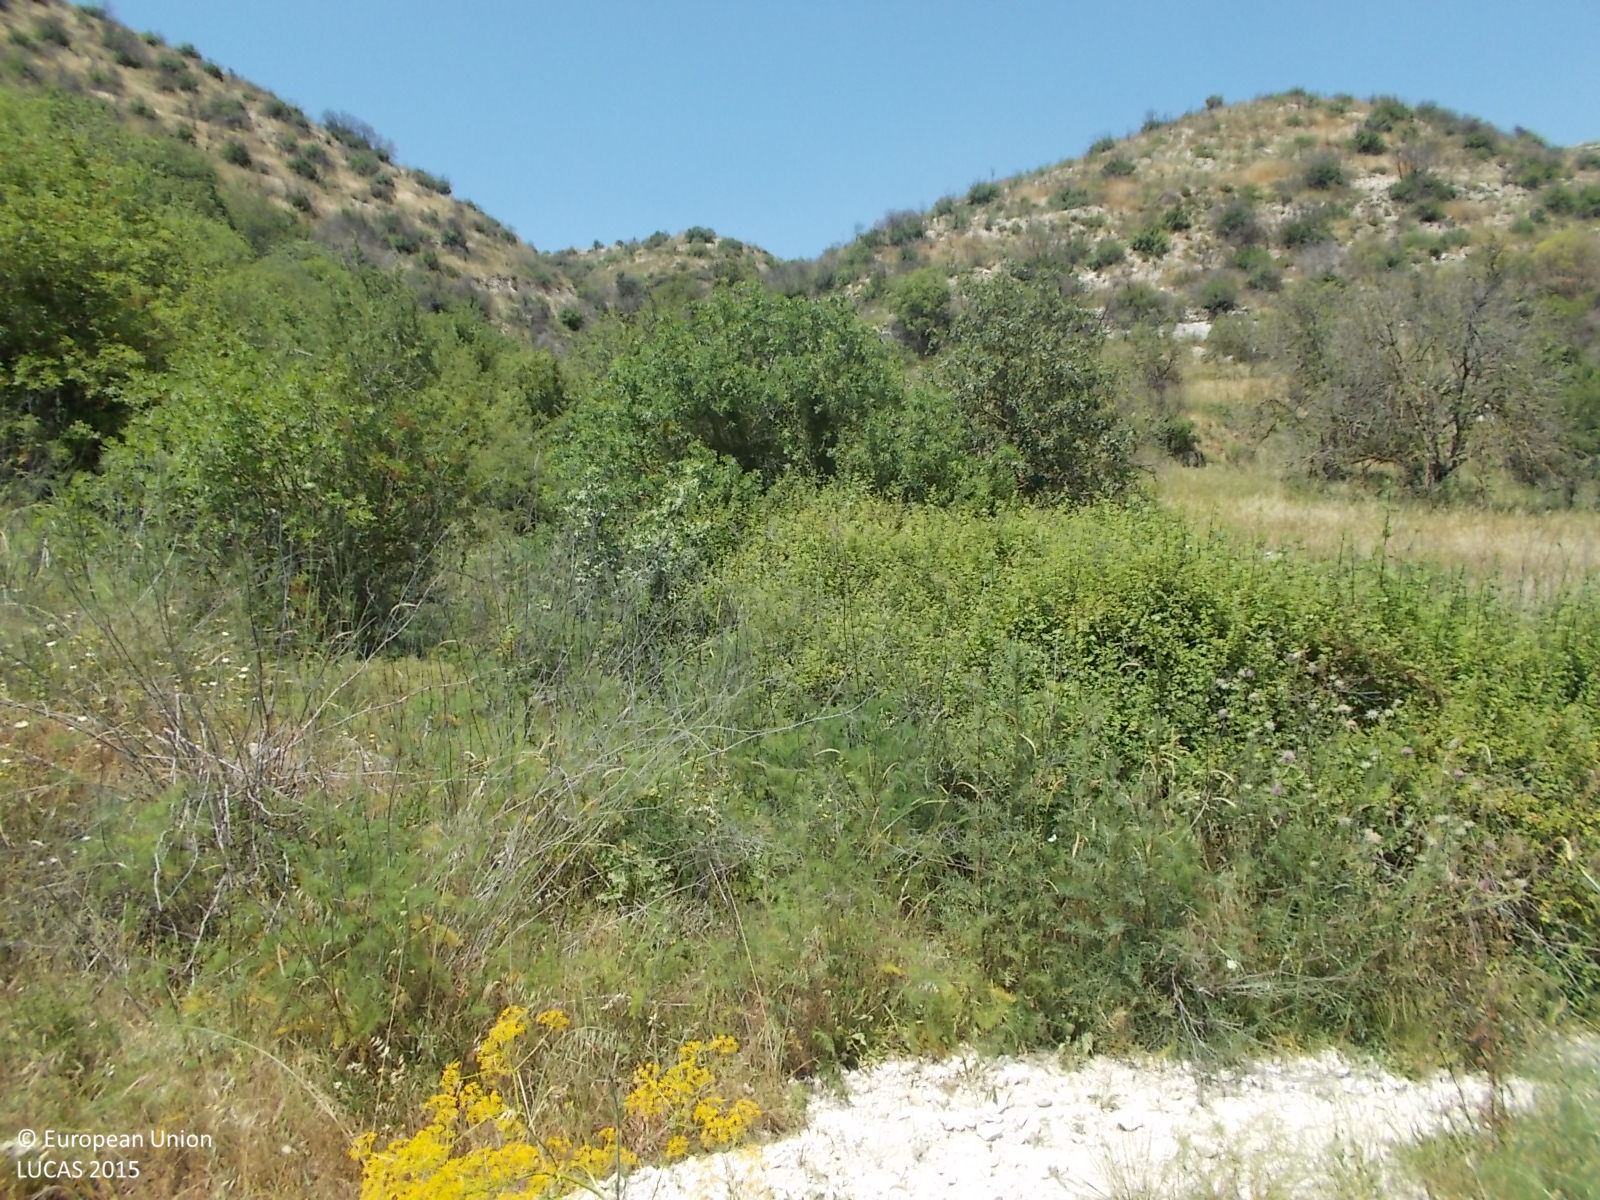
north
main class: Woodland
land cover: Broadleaved woodland
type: broadleaved evergreen forest
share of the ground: > 75 %
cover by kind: broadleaved forest trees 45 %, shrubs 30 %, herbaceous plants 10 %, consolidated bare surface 10 %, unconsolidated bare surface 5 %
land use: Semi-natural and natural areas not in use
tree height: > 5 m
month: May
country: CY
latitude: 34.8751
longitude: 32.4562
